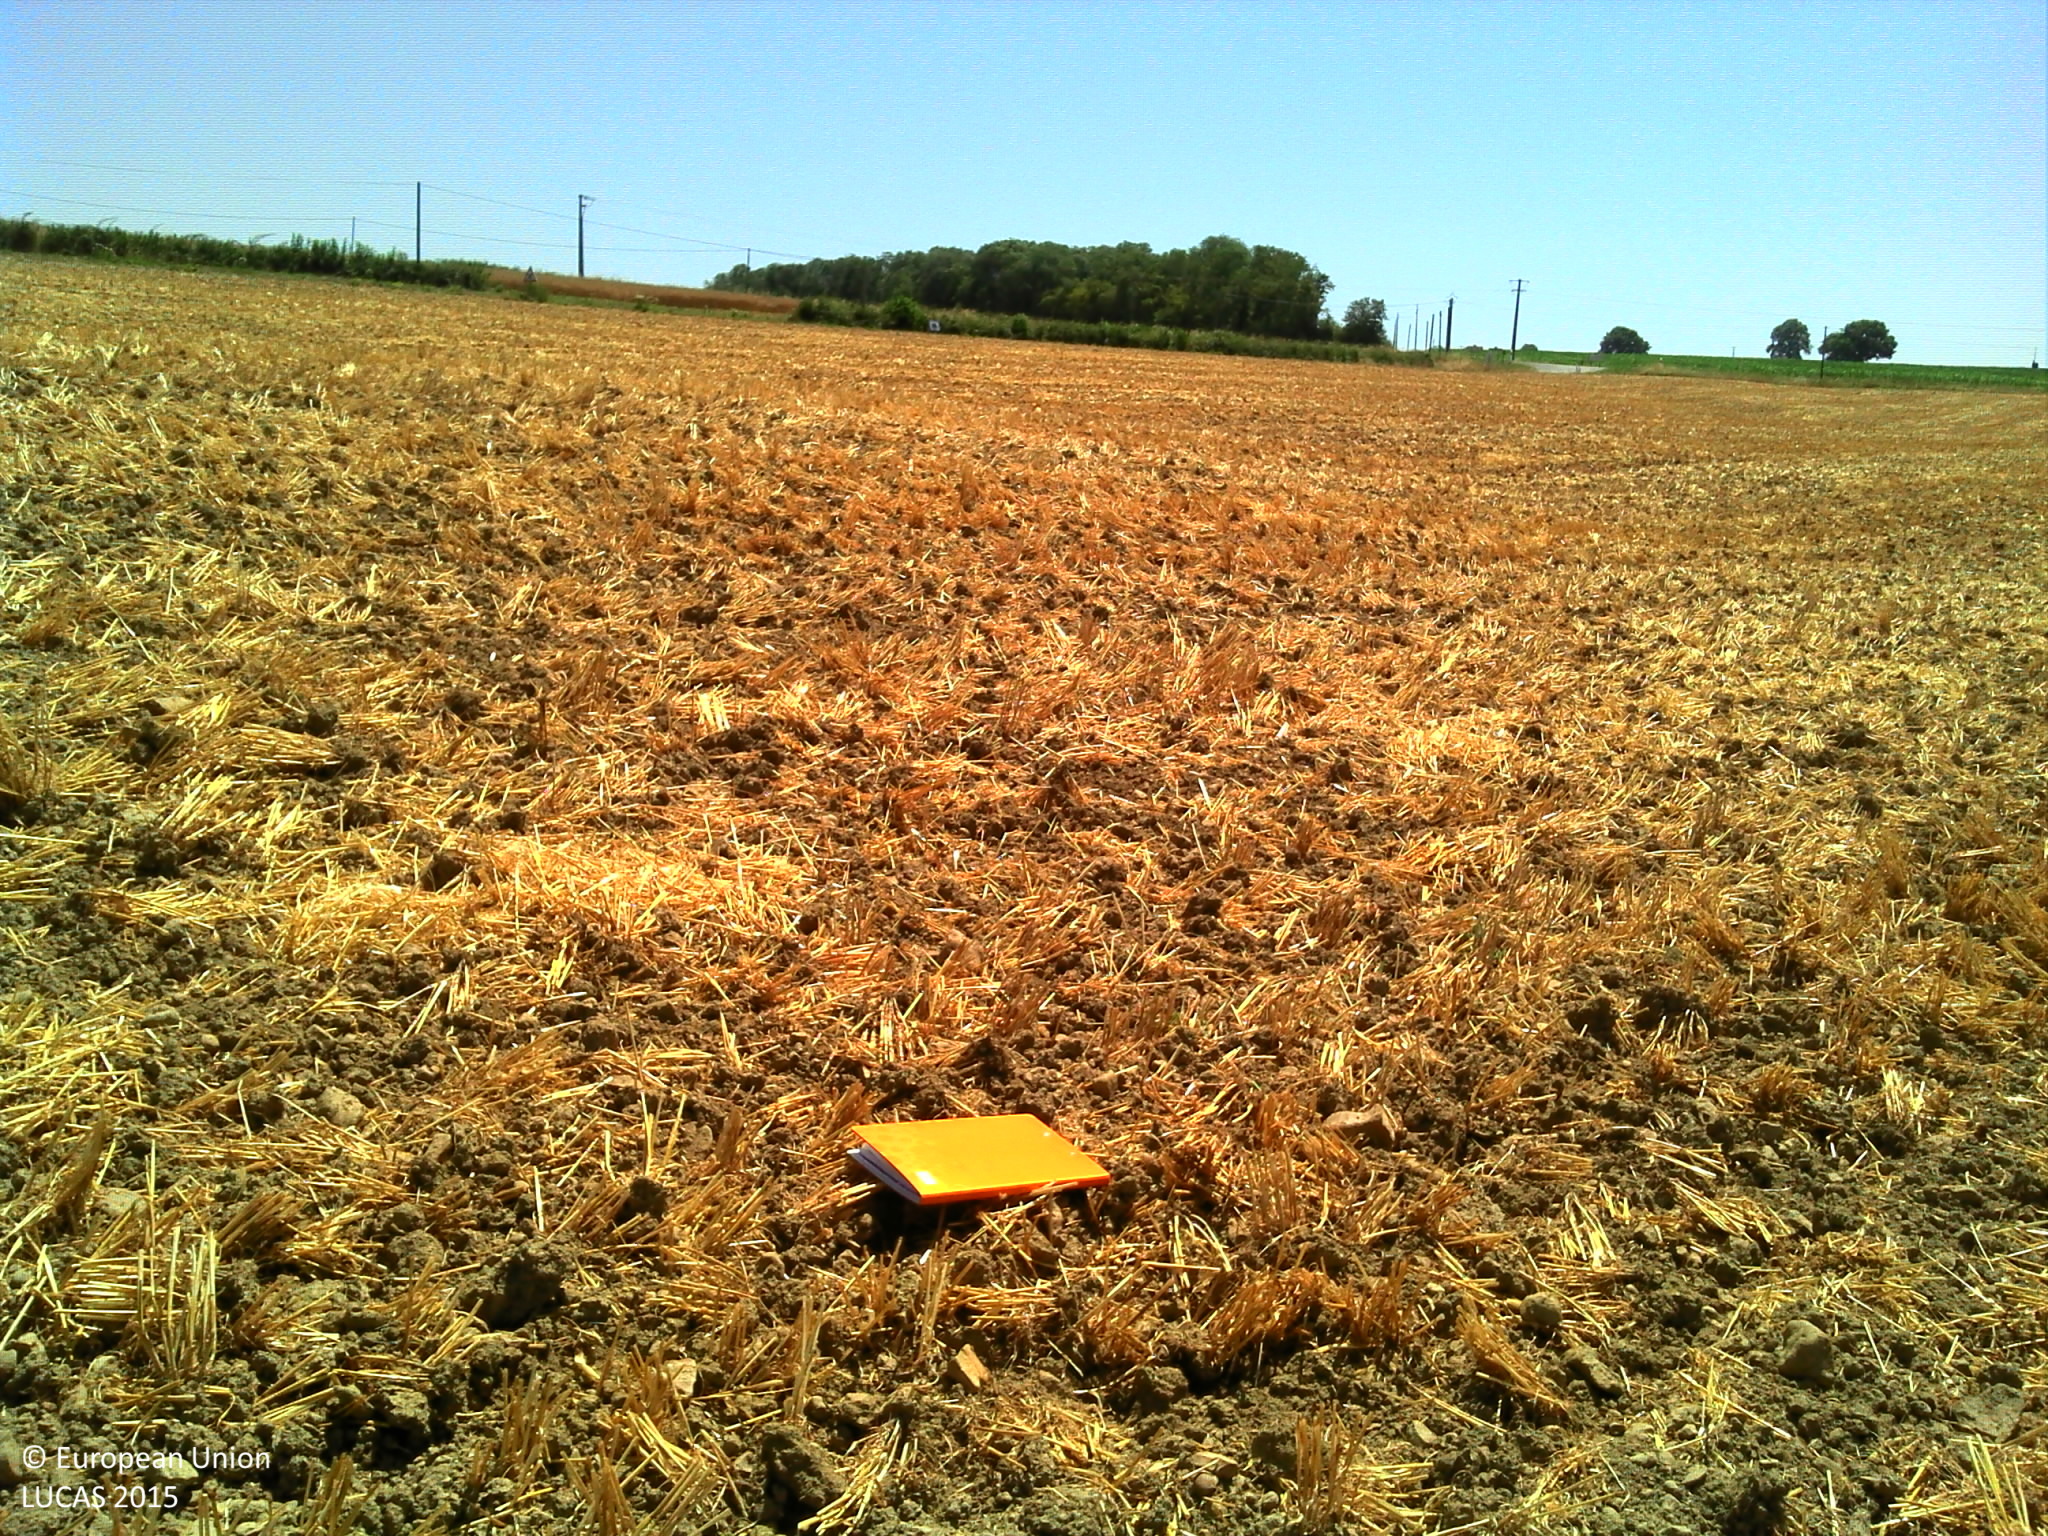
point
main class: Cropland
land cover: Barley
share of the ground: > 75 %
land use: Agriculture (excluding fallow land and kitchen gardens)
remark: Harvested field
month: July
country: FR
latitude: 46.9152
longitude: 3.5508
